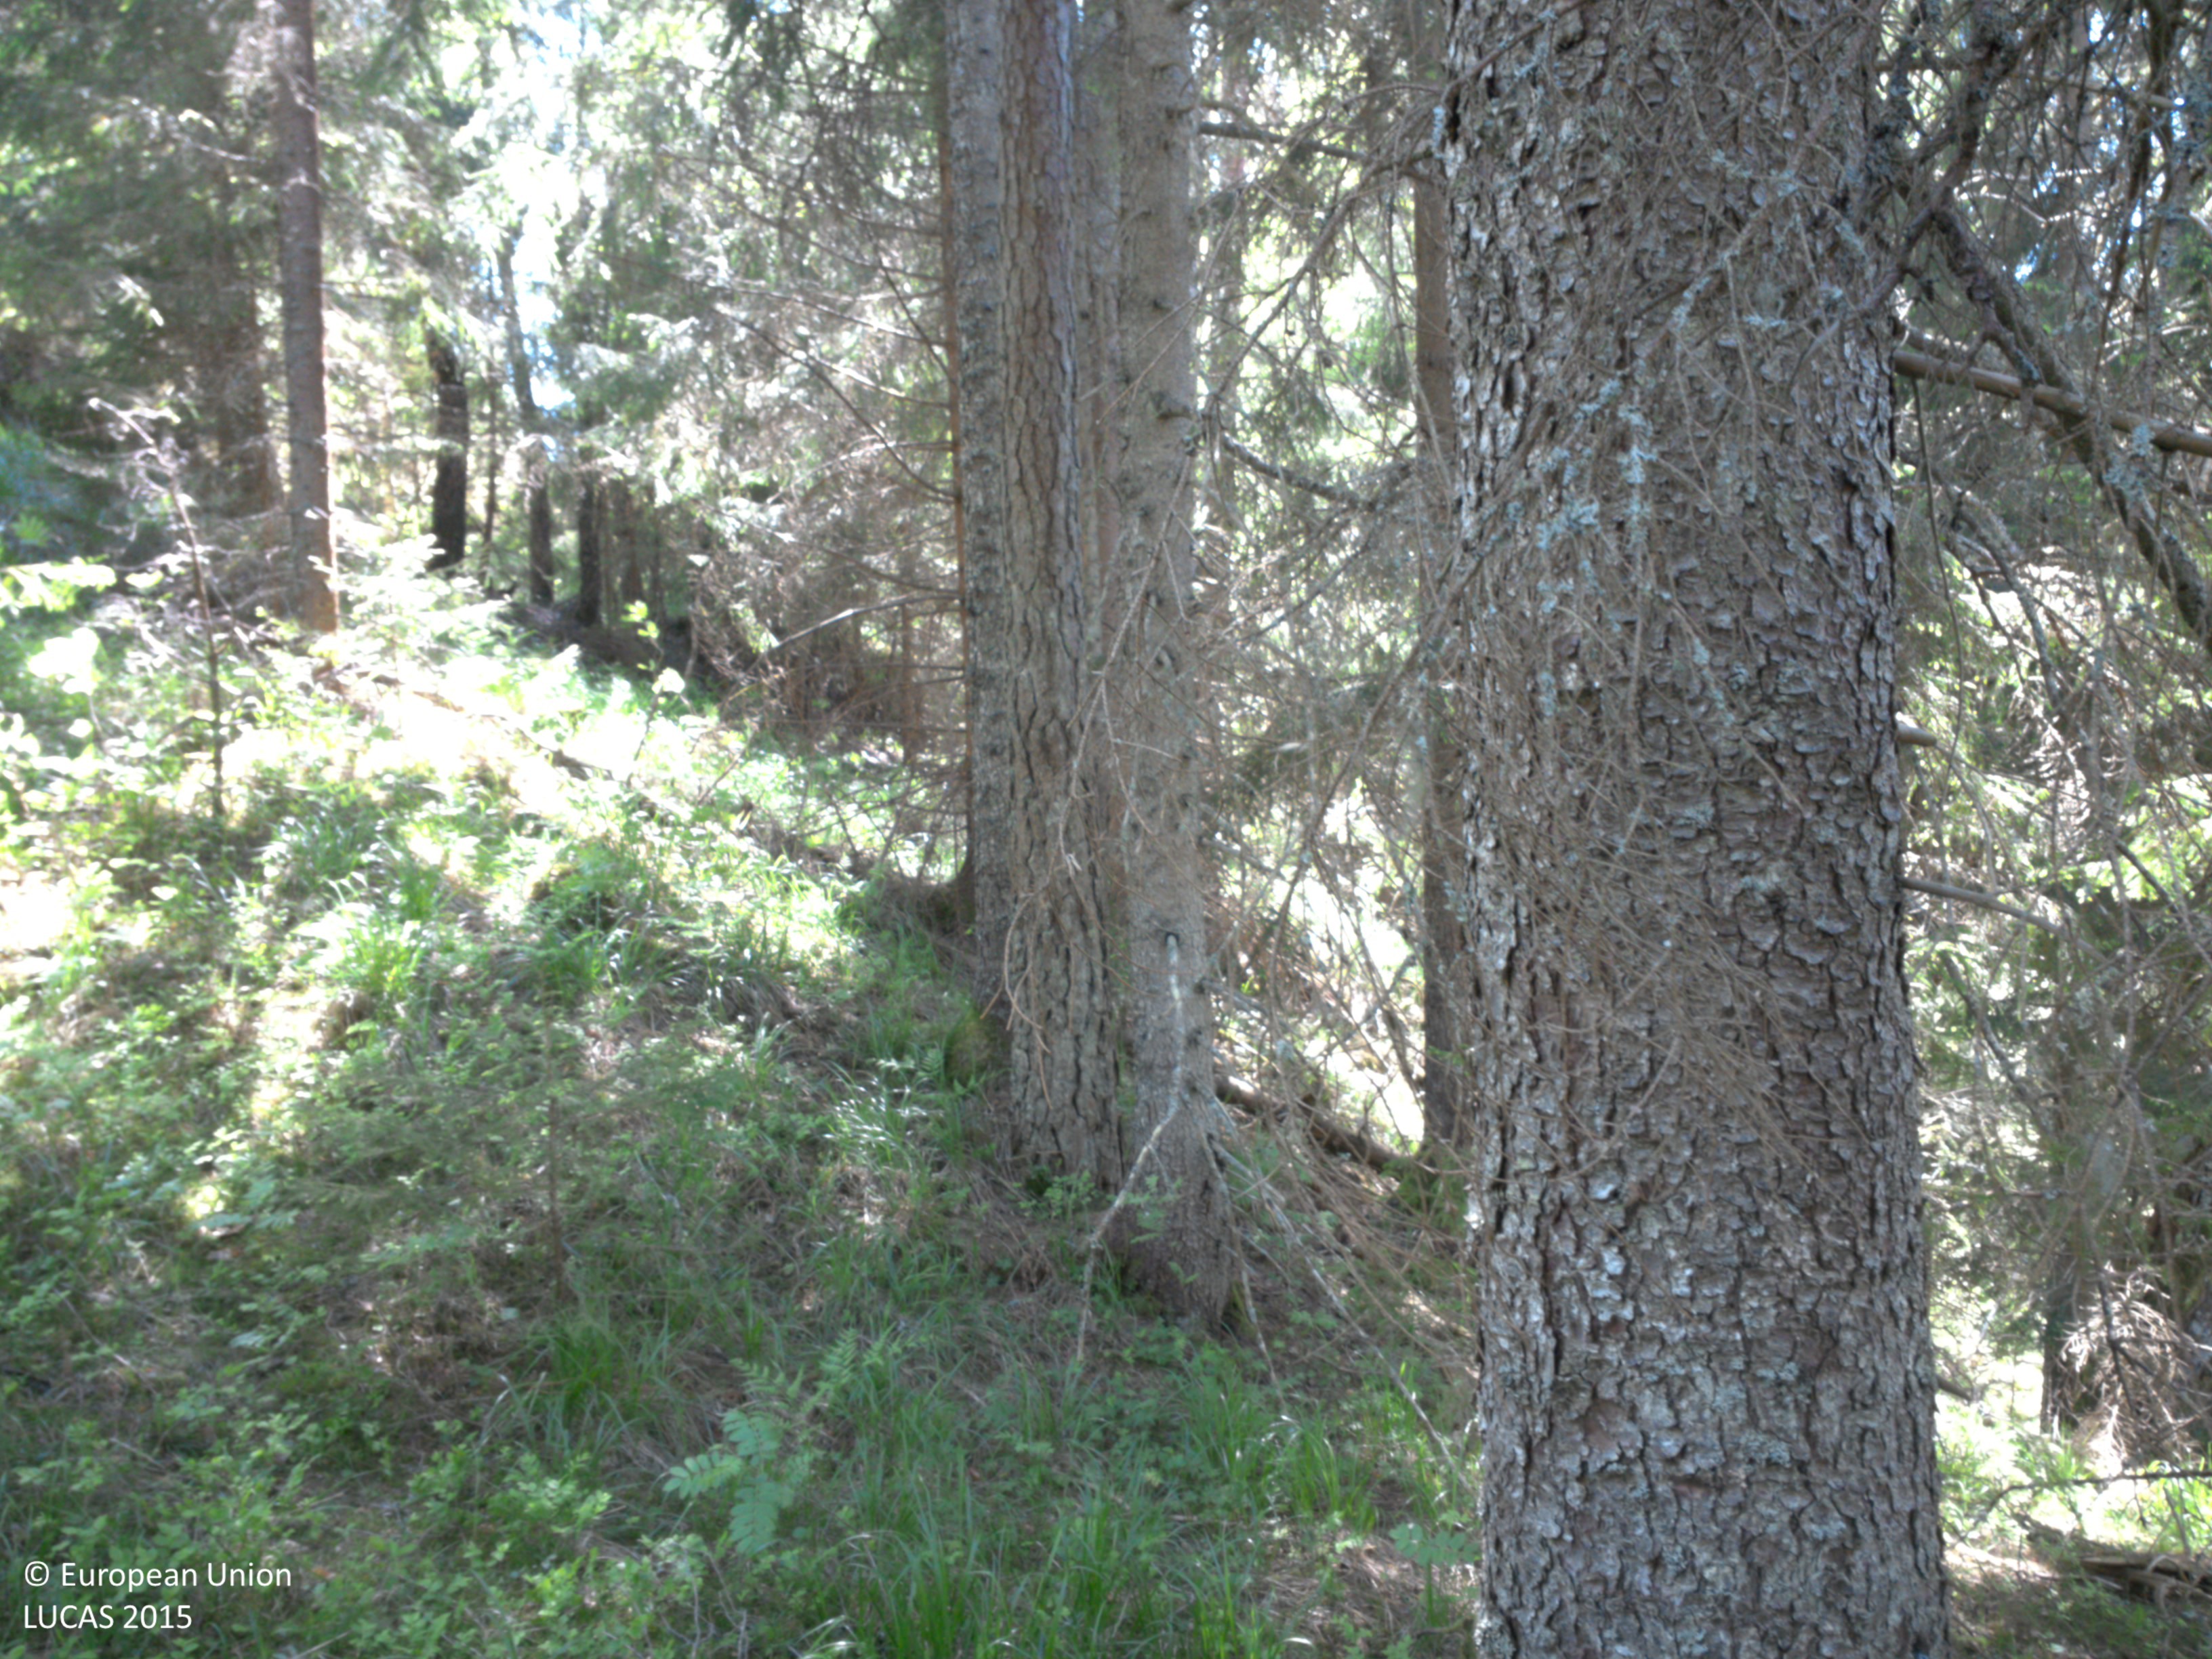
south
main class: Woodland
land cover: Other coniferous woodland
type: boreal forest
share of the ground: 50 - 75 %
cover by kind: coniferous forest trees 60 %, lichens and mosses 20 %, shrubs 10 %, herbaceous plants 10 %
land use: Forestry
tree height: > 5 m
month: June
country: SE
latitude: 59.0628
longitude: 12.3488
